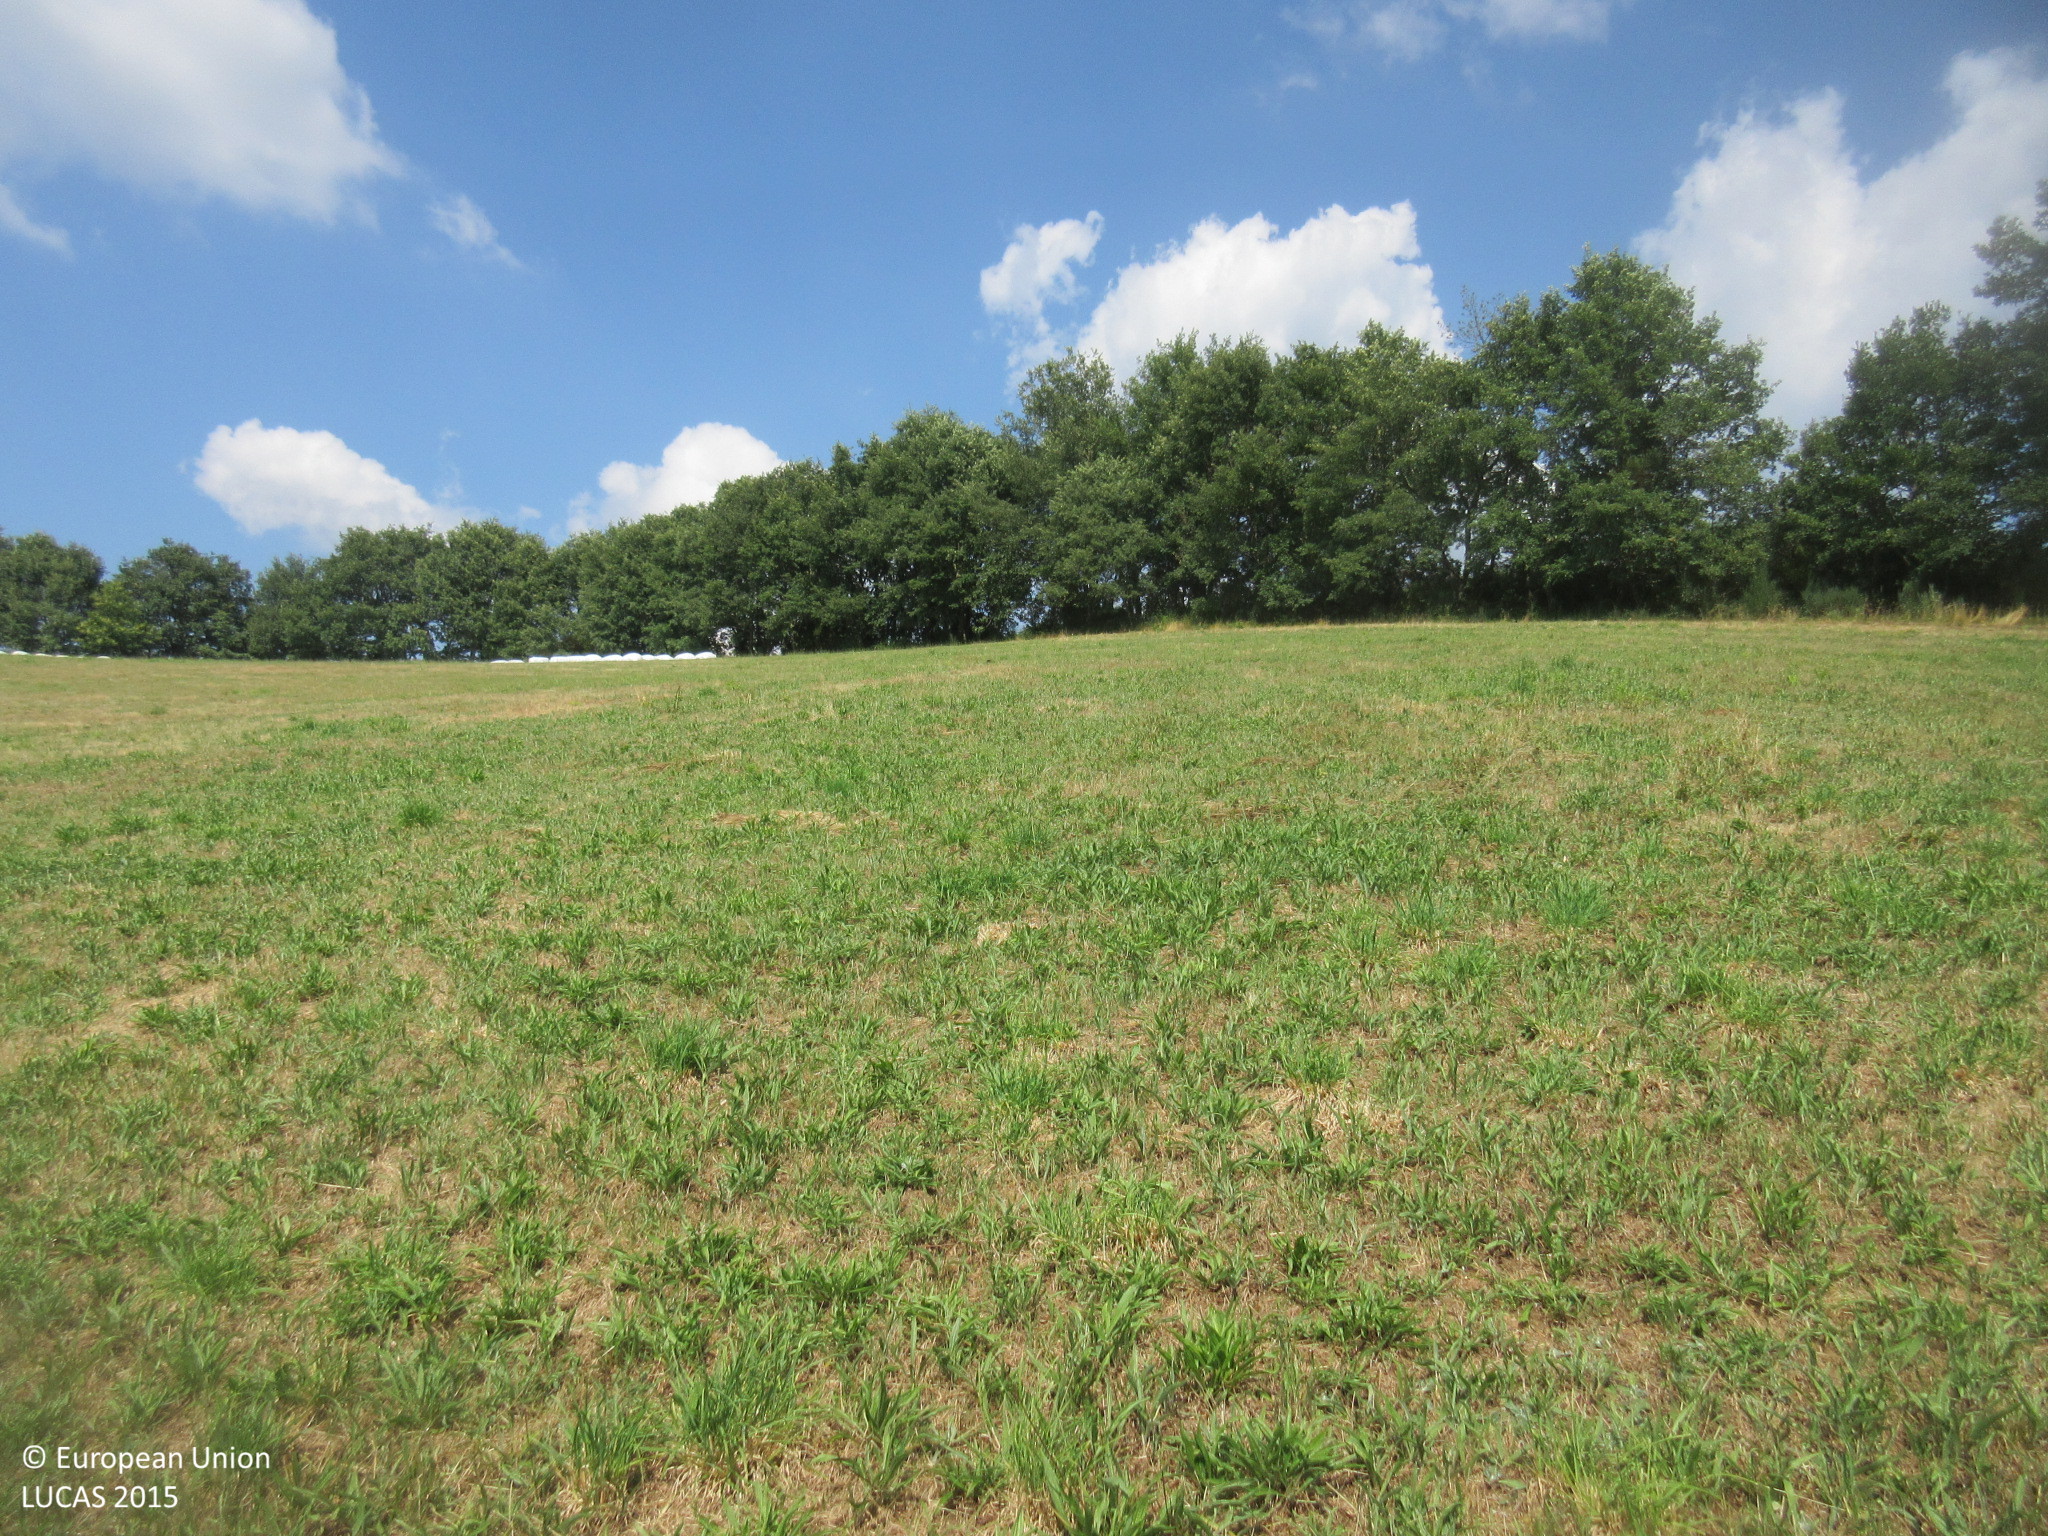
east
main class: Grassland
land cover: Grassland without tree/shrub cover
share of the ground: > 75 %
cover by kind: herbaceous plants 100 %
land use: Agriculture (excluding fallow land and kitchen gardens)
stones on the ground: 25 - 50 %
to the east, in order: Grassland without tree/shrub cover; Groves; Dry stone walls; Tracks; Shrubland without tree cover; Electric lines; Shrubland without tree cover; Grassland without tree/shrub cover; Abandoned hedges; Grassland without tree/shrub cover
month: June
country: ES
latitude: 42.9729
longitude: -6.9946
